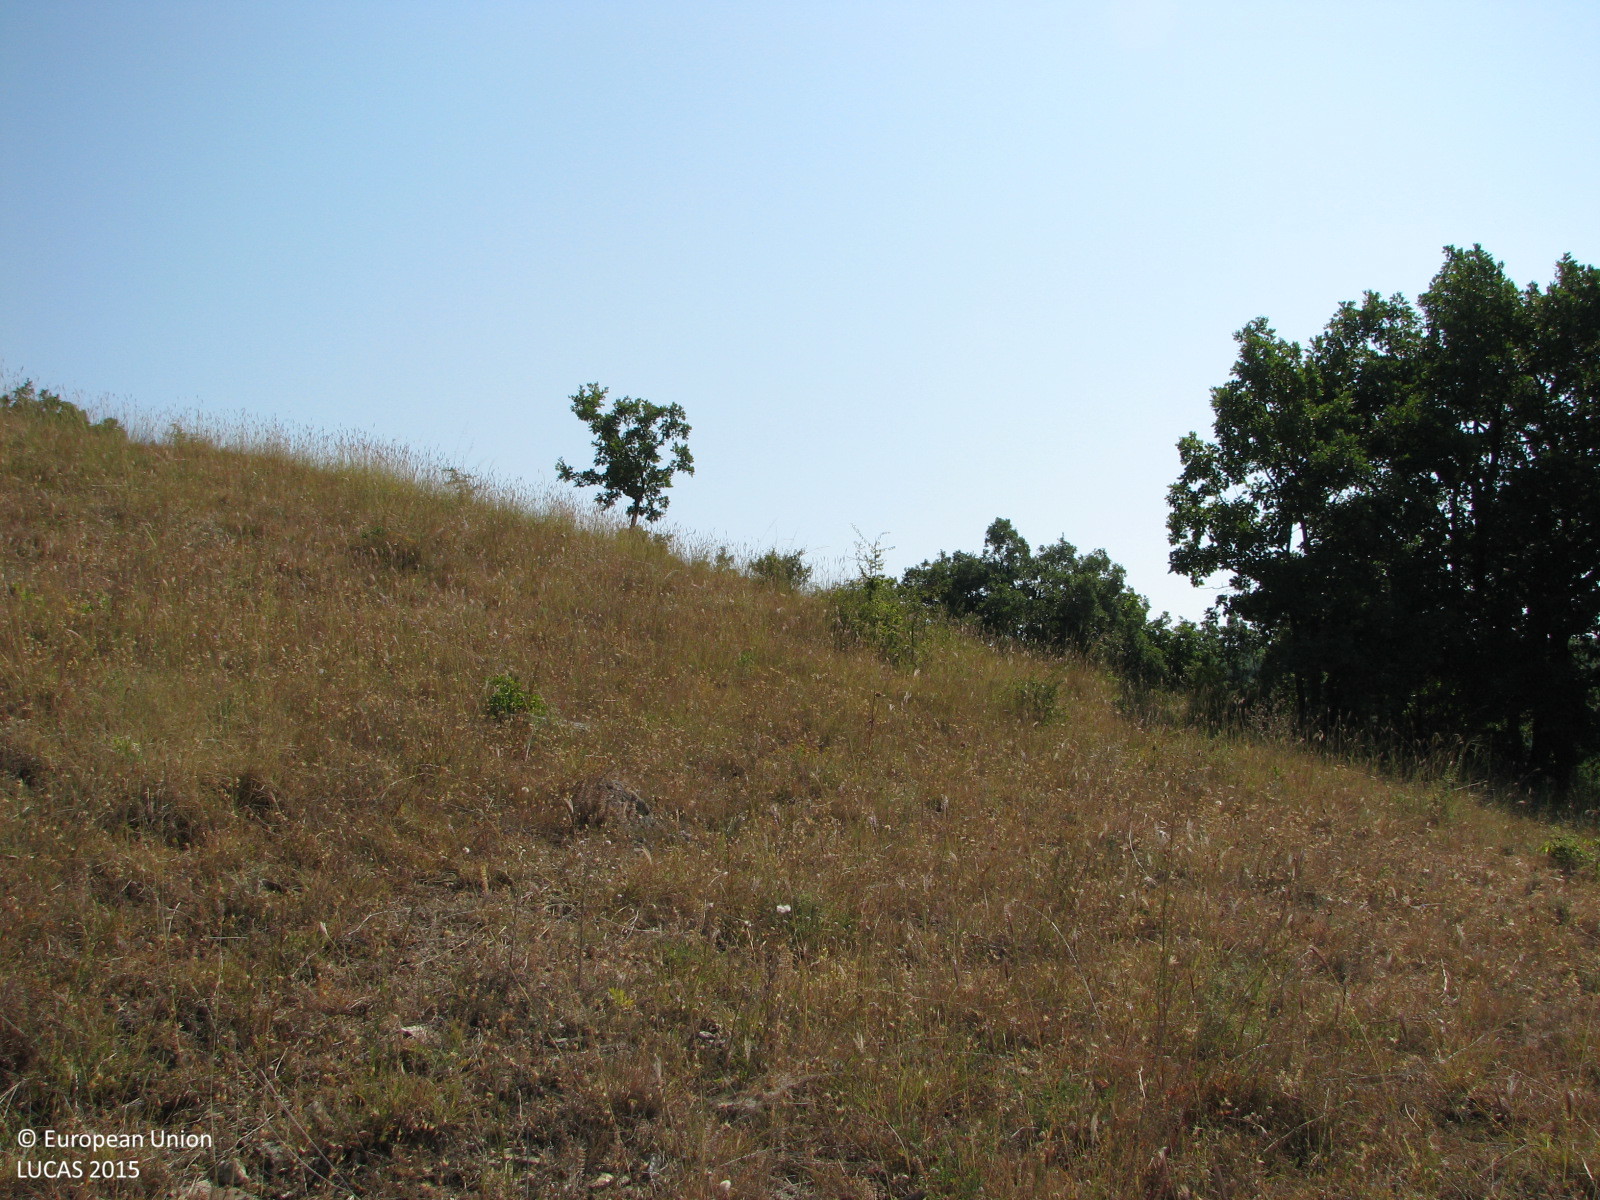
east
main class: Grassland
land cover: Grassland with sparse tree/shrub cover
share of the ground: > 75 %
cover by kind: herbaceous plants 90 %, broadleaved forest trees 5 %, shrubs 5 %
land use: Agriculture (excluding fallow land and kitchen gardens)
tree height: > 5 m
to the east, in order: Grassland with sparse tree/shrub cover; Grassland without tree/shrub cover; Broadleaved woodland; Grassland without tree/shrub cover; Cherry fruit; Grassland without tree/shrub cover; Broadleaved woodland; Rivers and streams; Broadleaved woodland; Grassland without tree/shrub cover; Cherry fruit
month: July
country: BG
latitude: 42.6741
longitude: 26.1321
